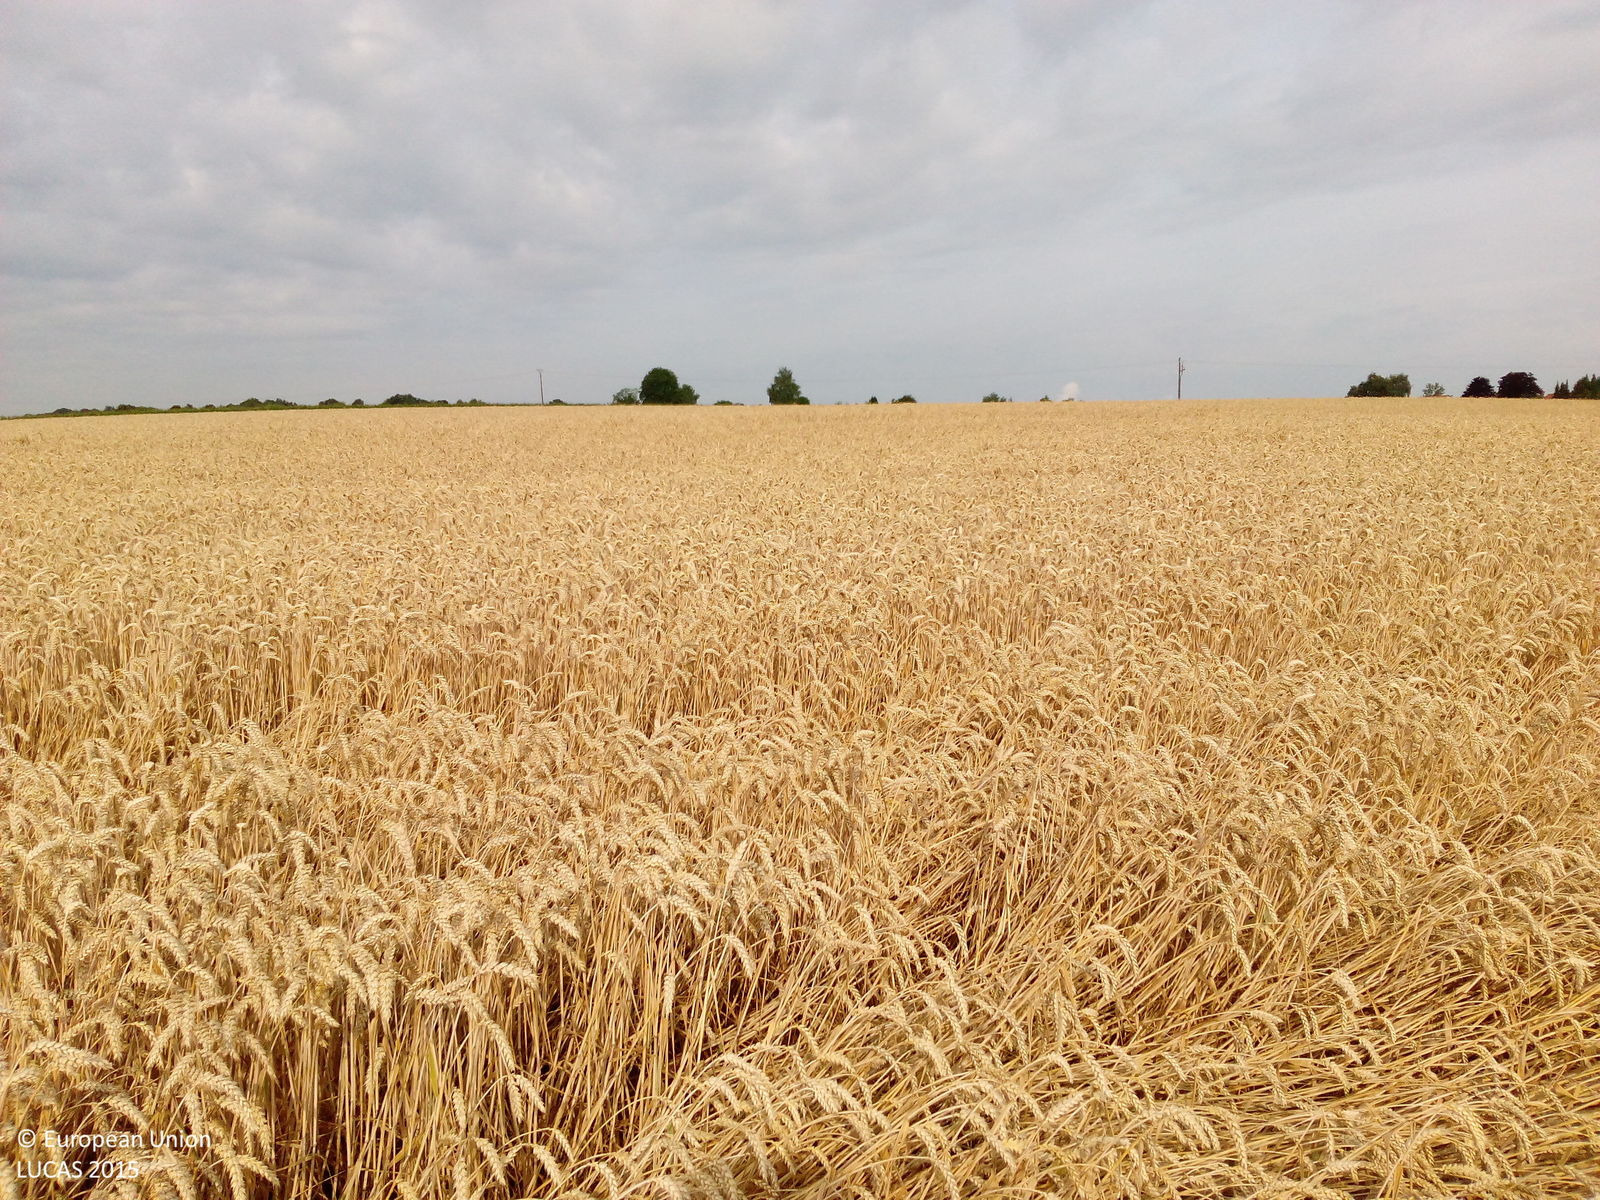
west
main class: Cropland
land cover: Common wheat
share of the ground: > 75 %
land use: Agriculture (excluding fallow land and kitchen gardens)
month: July
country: DE
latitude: 51.5146
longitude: 9.8704
